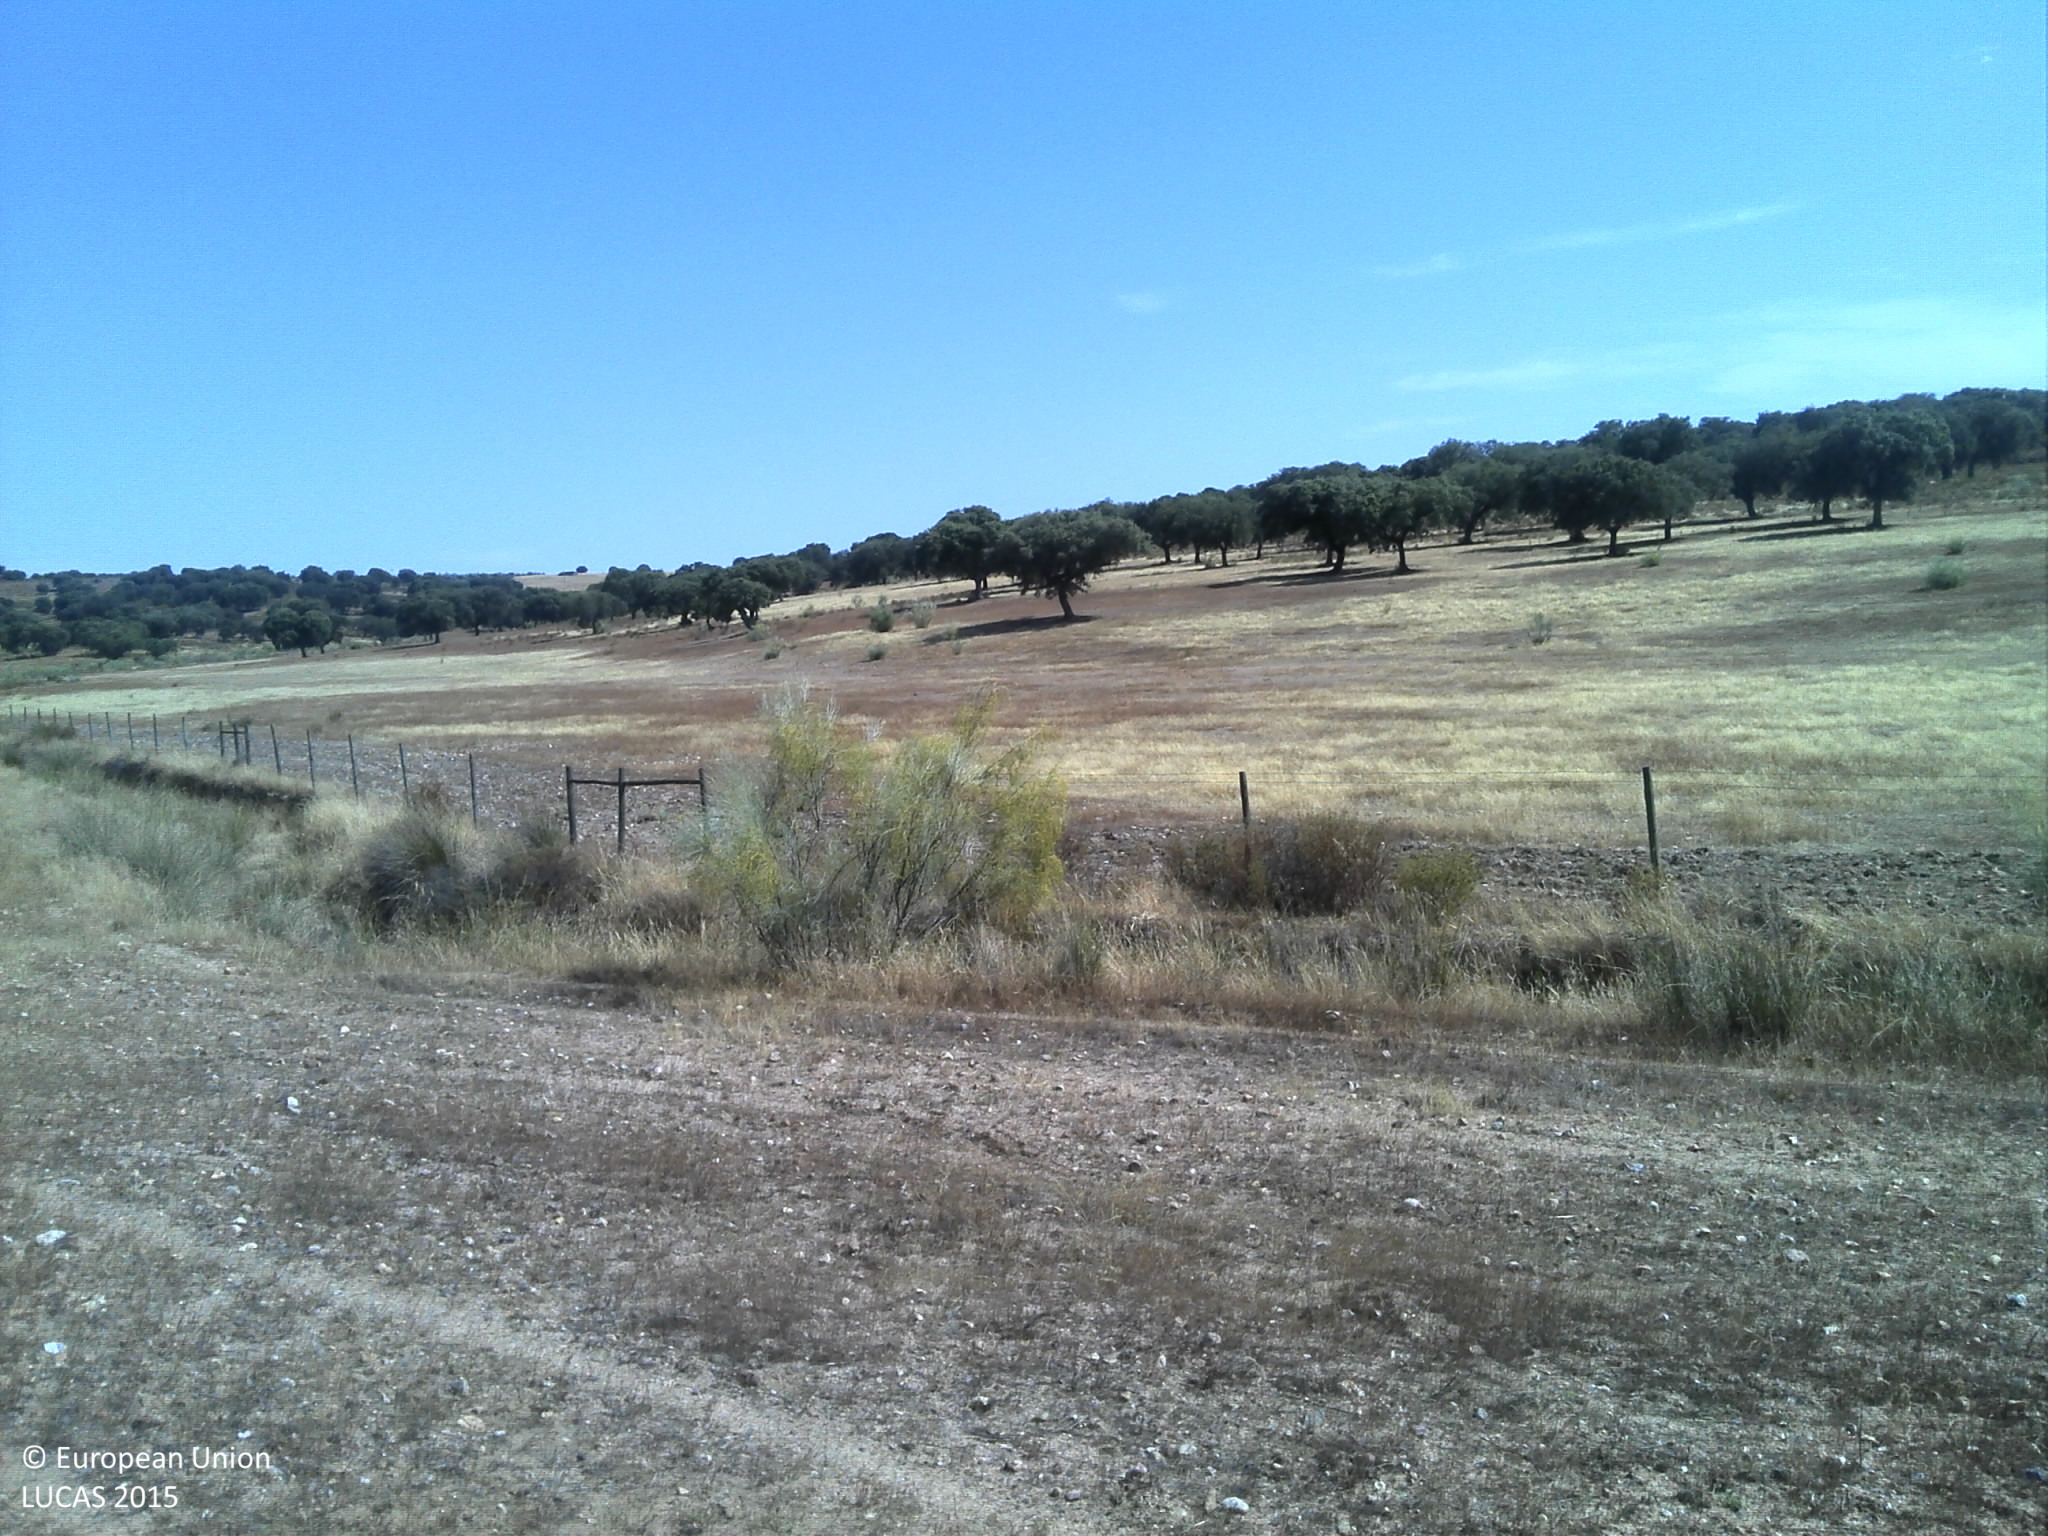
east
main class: Grassland
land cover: Grassland without tree/shrub cover
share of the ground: 10 - 25 %
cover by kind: unconsolidated bare surface 75 %, herbaceous plants 25 %
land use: Agriculture (excluding fallow land and kitchen gardens)
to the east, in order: Grassland without tree/shrub cover; Broadleaved woodland; Grassland without tree/shrub cover; Rivers and streams; Grassland without tree/shrub cover; Broadleaved woodland
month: June
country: PT
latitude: 39.7683
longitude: -7.0976
